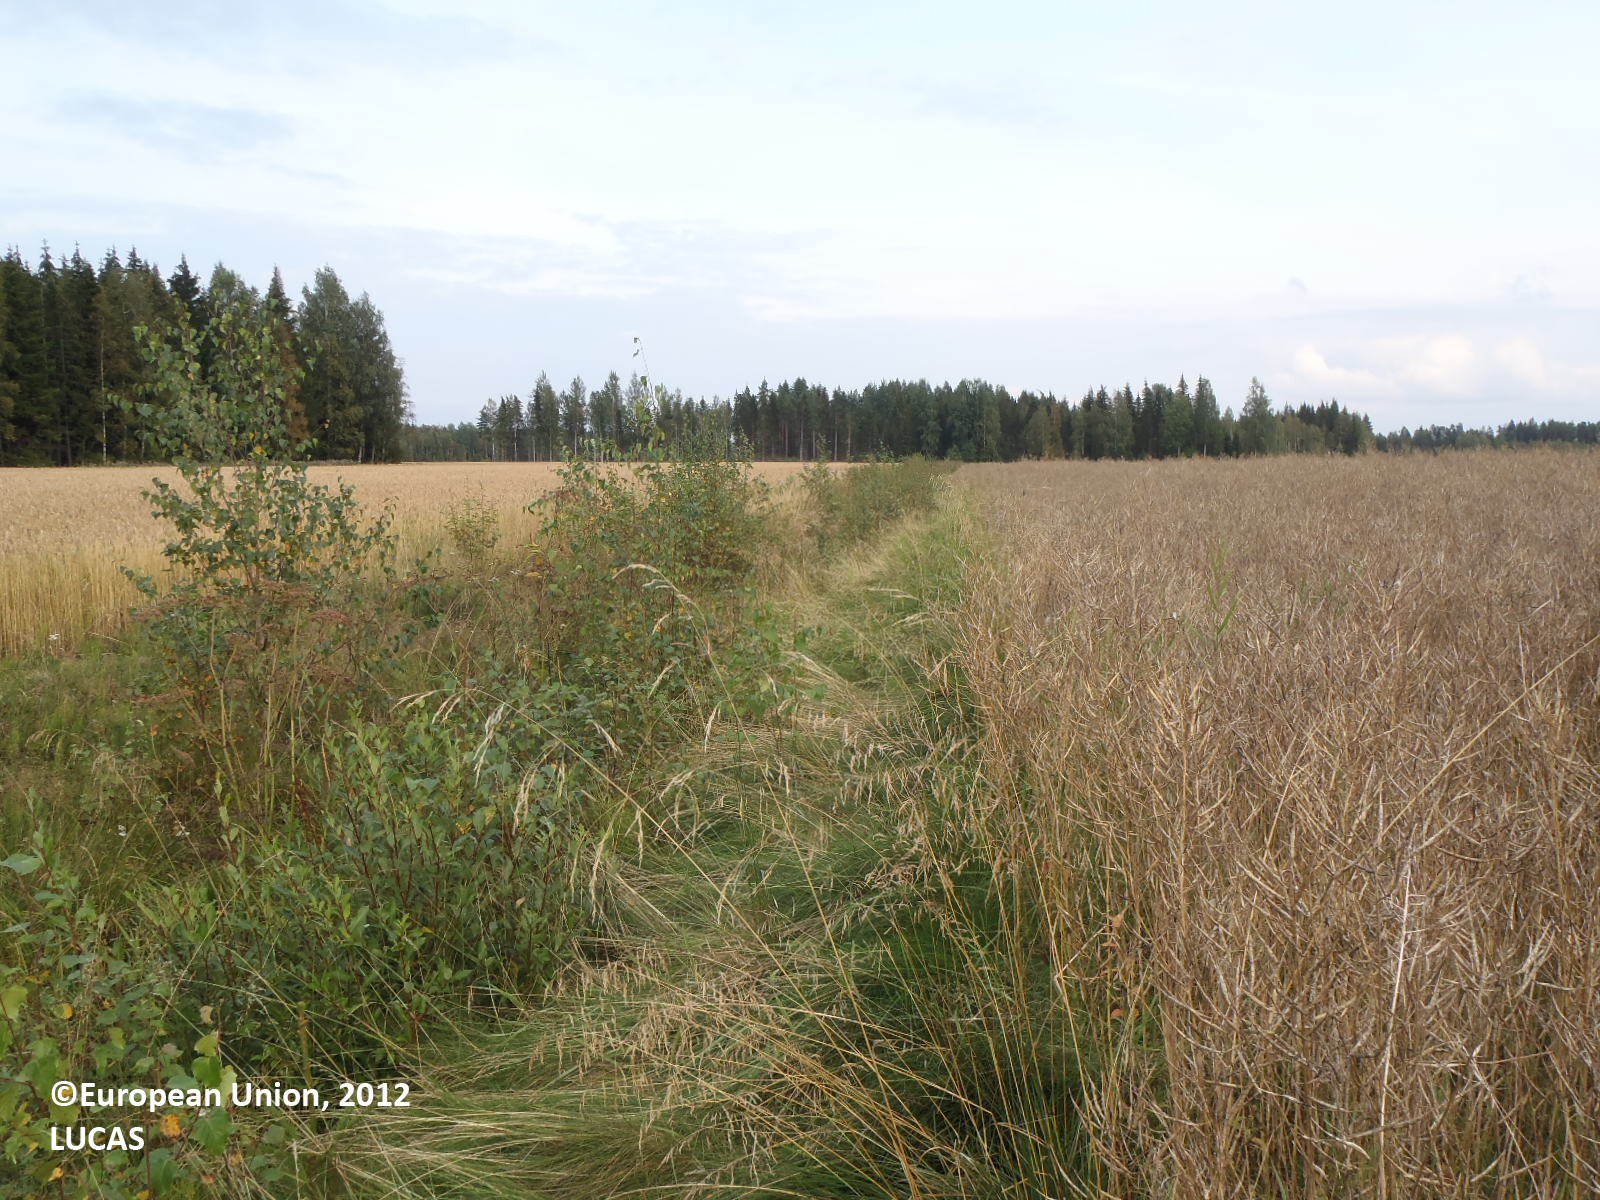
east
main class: Cropland
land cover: Rape and turnip rape
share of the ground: > 75 %
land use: Agriculture (excluding fallow land and kitchen gardens)
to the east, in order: Rape and turnip rape; Grass margins; Ditches and canals; Abandoned hedges; Grass margins; Common wheat
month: August
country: FI
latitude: 60.9318
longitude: 22.5598
